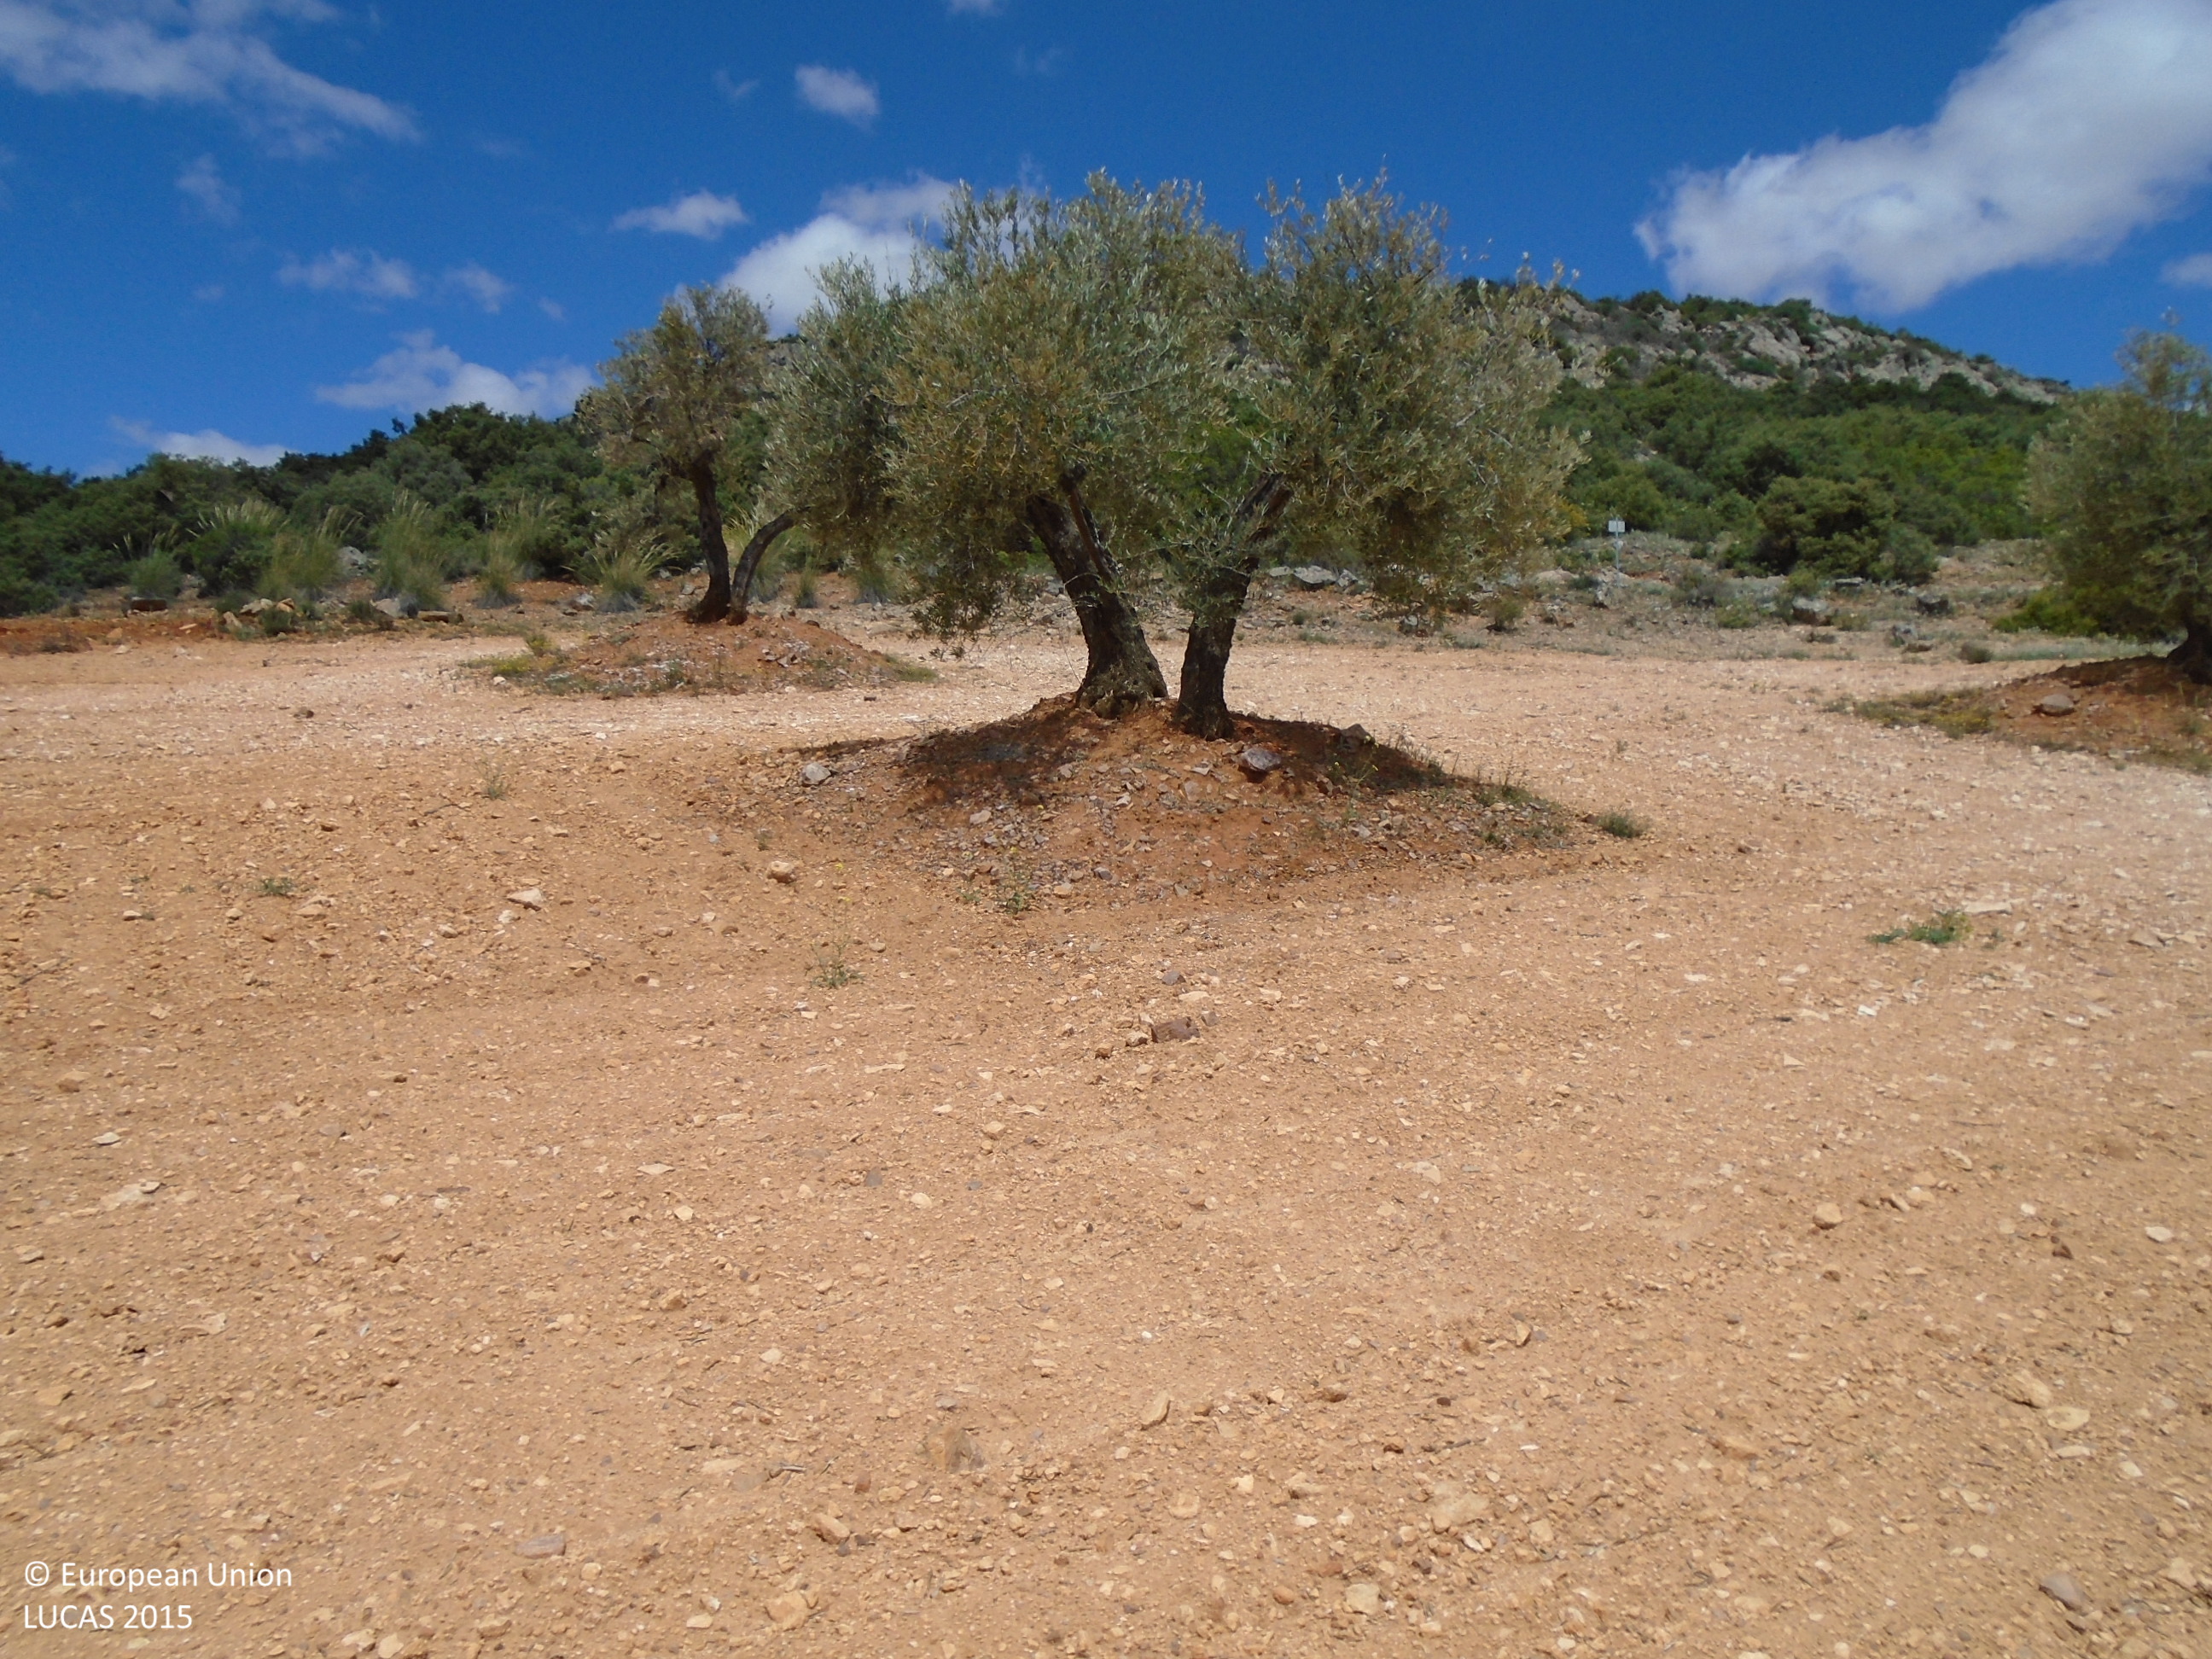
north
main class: Cropland
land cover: Olive groves
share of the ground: 10 - 25 %
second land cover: Other bare soil
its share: > 75 %
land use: Agriculture (excluding fallow land and kitchen gardens)
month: May
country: ES
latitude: 39.6433
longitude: -3.7431
